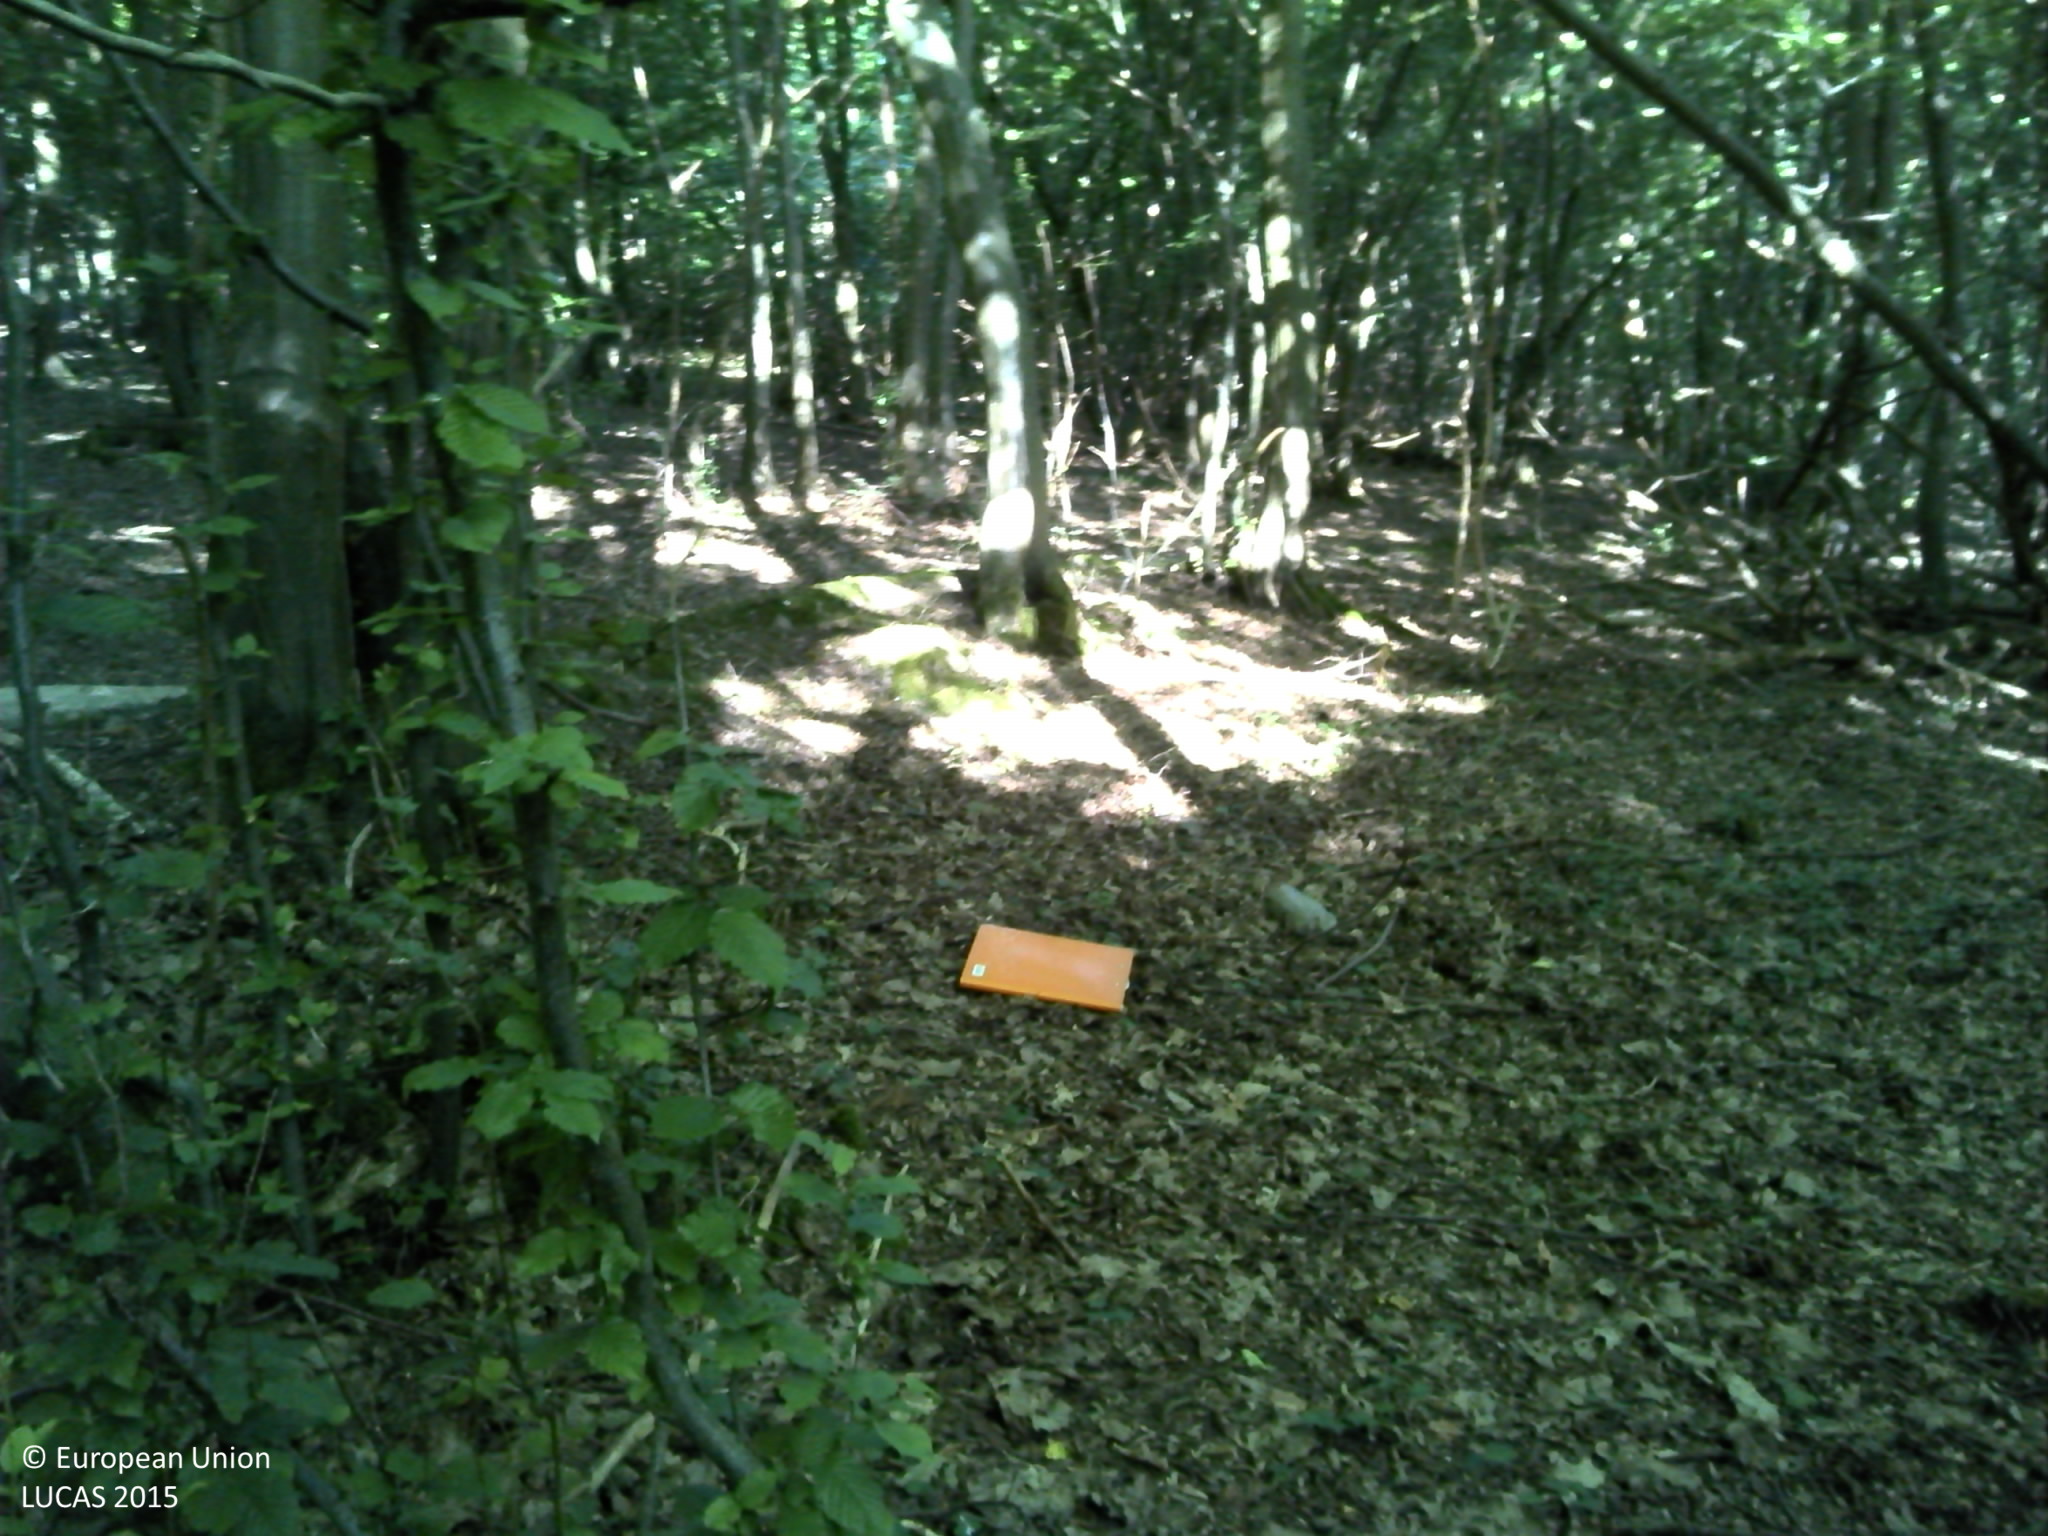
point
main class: Woodland
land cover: Broadleaved woodland
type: mesophytic deciduous forest
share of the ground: > 75 %
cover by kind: broadleaved forest trees 100 %
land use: Forestry
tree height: > 5 m
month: June
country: FR
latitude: 49.2692
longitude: 1.0314
